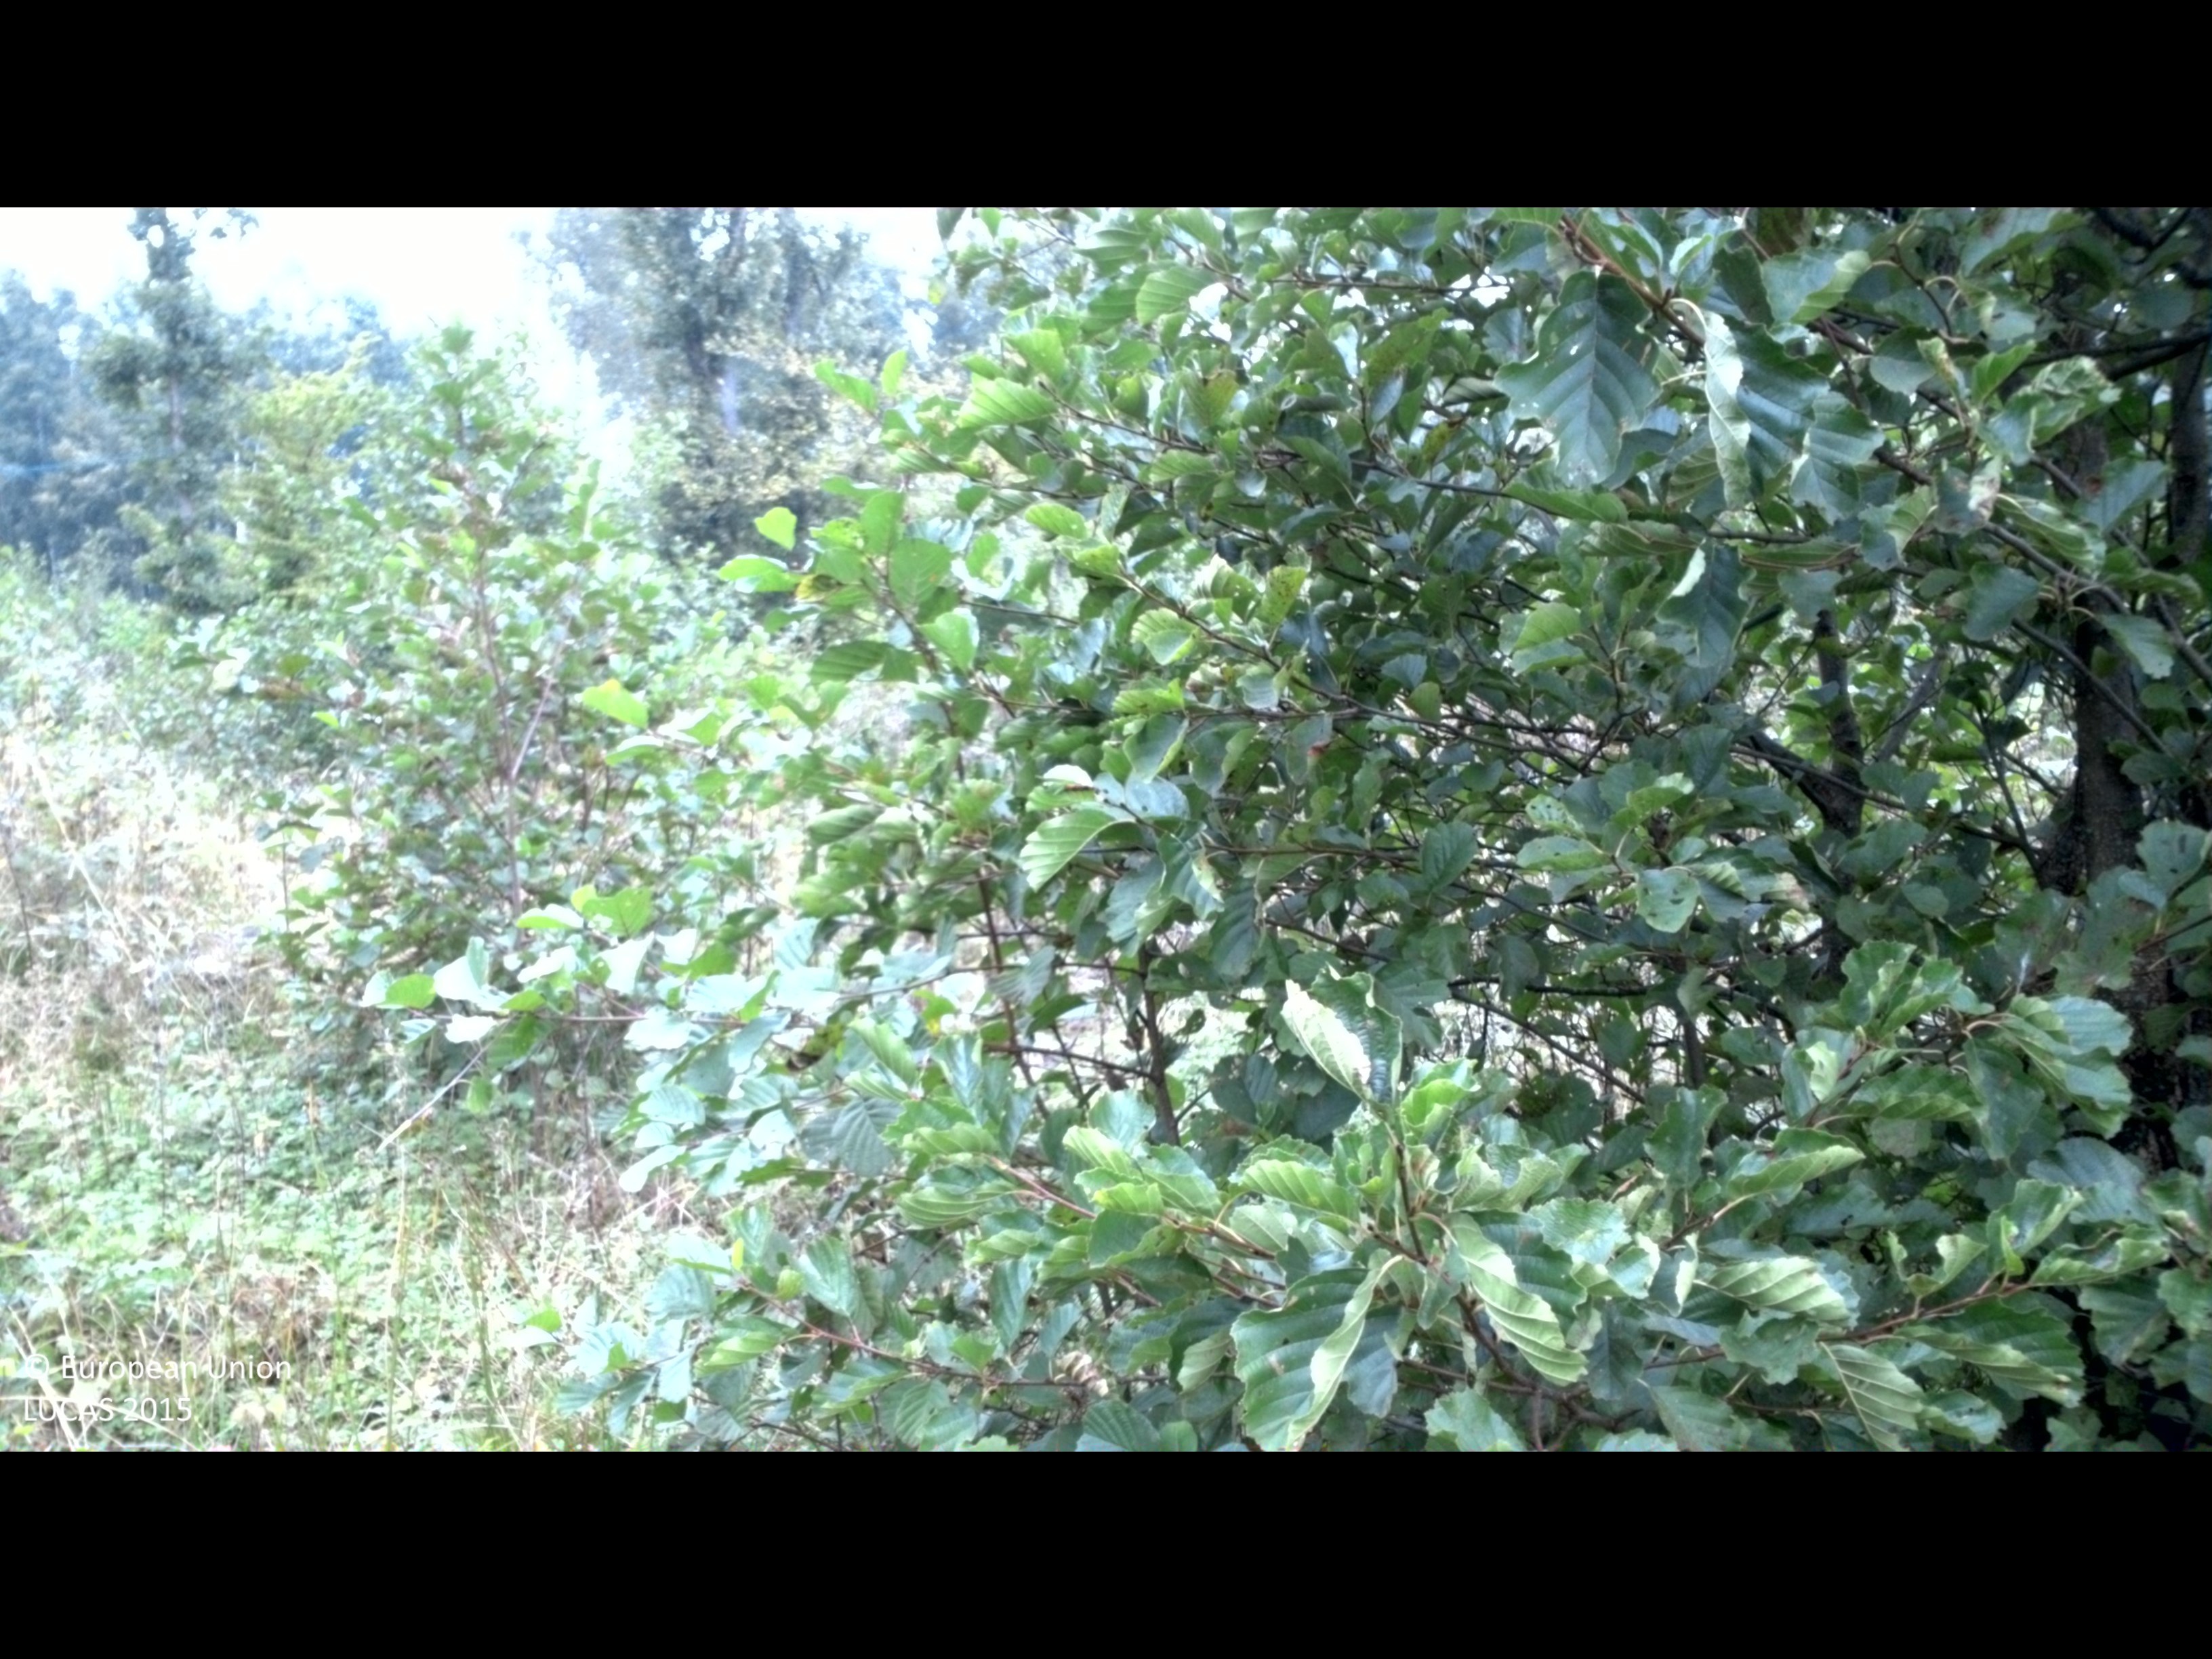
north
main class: Woodland
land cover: Broadleaved woodland
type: hemiboreal forest and nemoral coniferous forest and mixed broadleaved-coniferous forest
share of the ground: 25 - 50 %
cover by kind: broadleaved forest trees 50 %, herbaceous plants 30 %, shrubs 20 %
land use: Forestry
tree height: < 5 m
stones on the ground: < 10 %
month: September
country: SE
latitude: 56.0167
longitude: 14.0243
